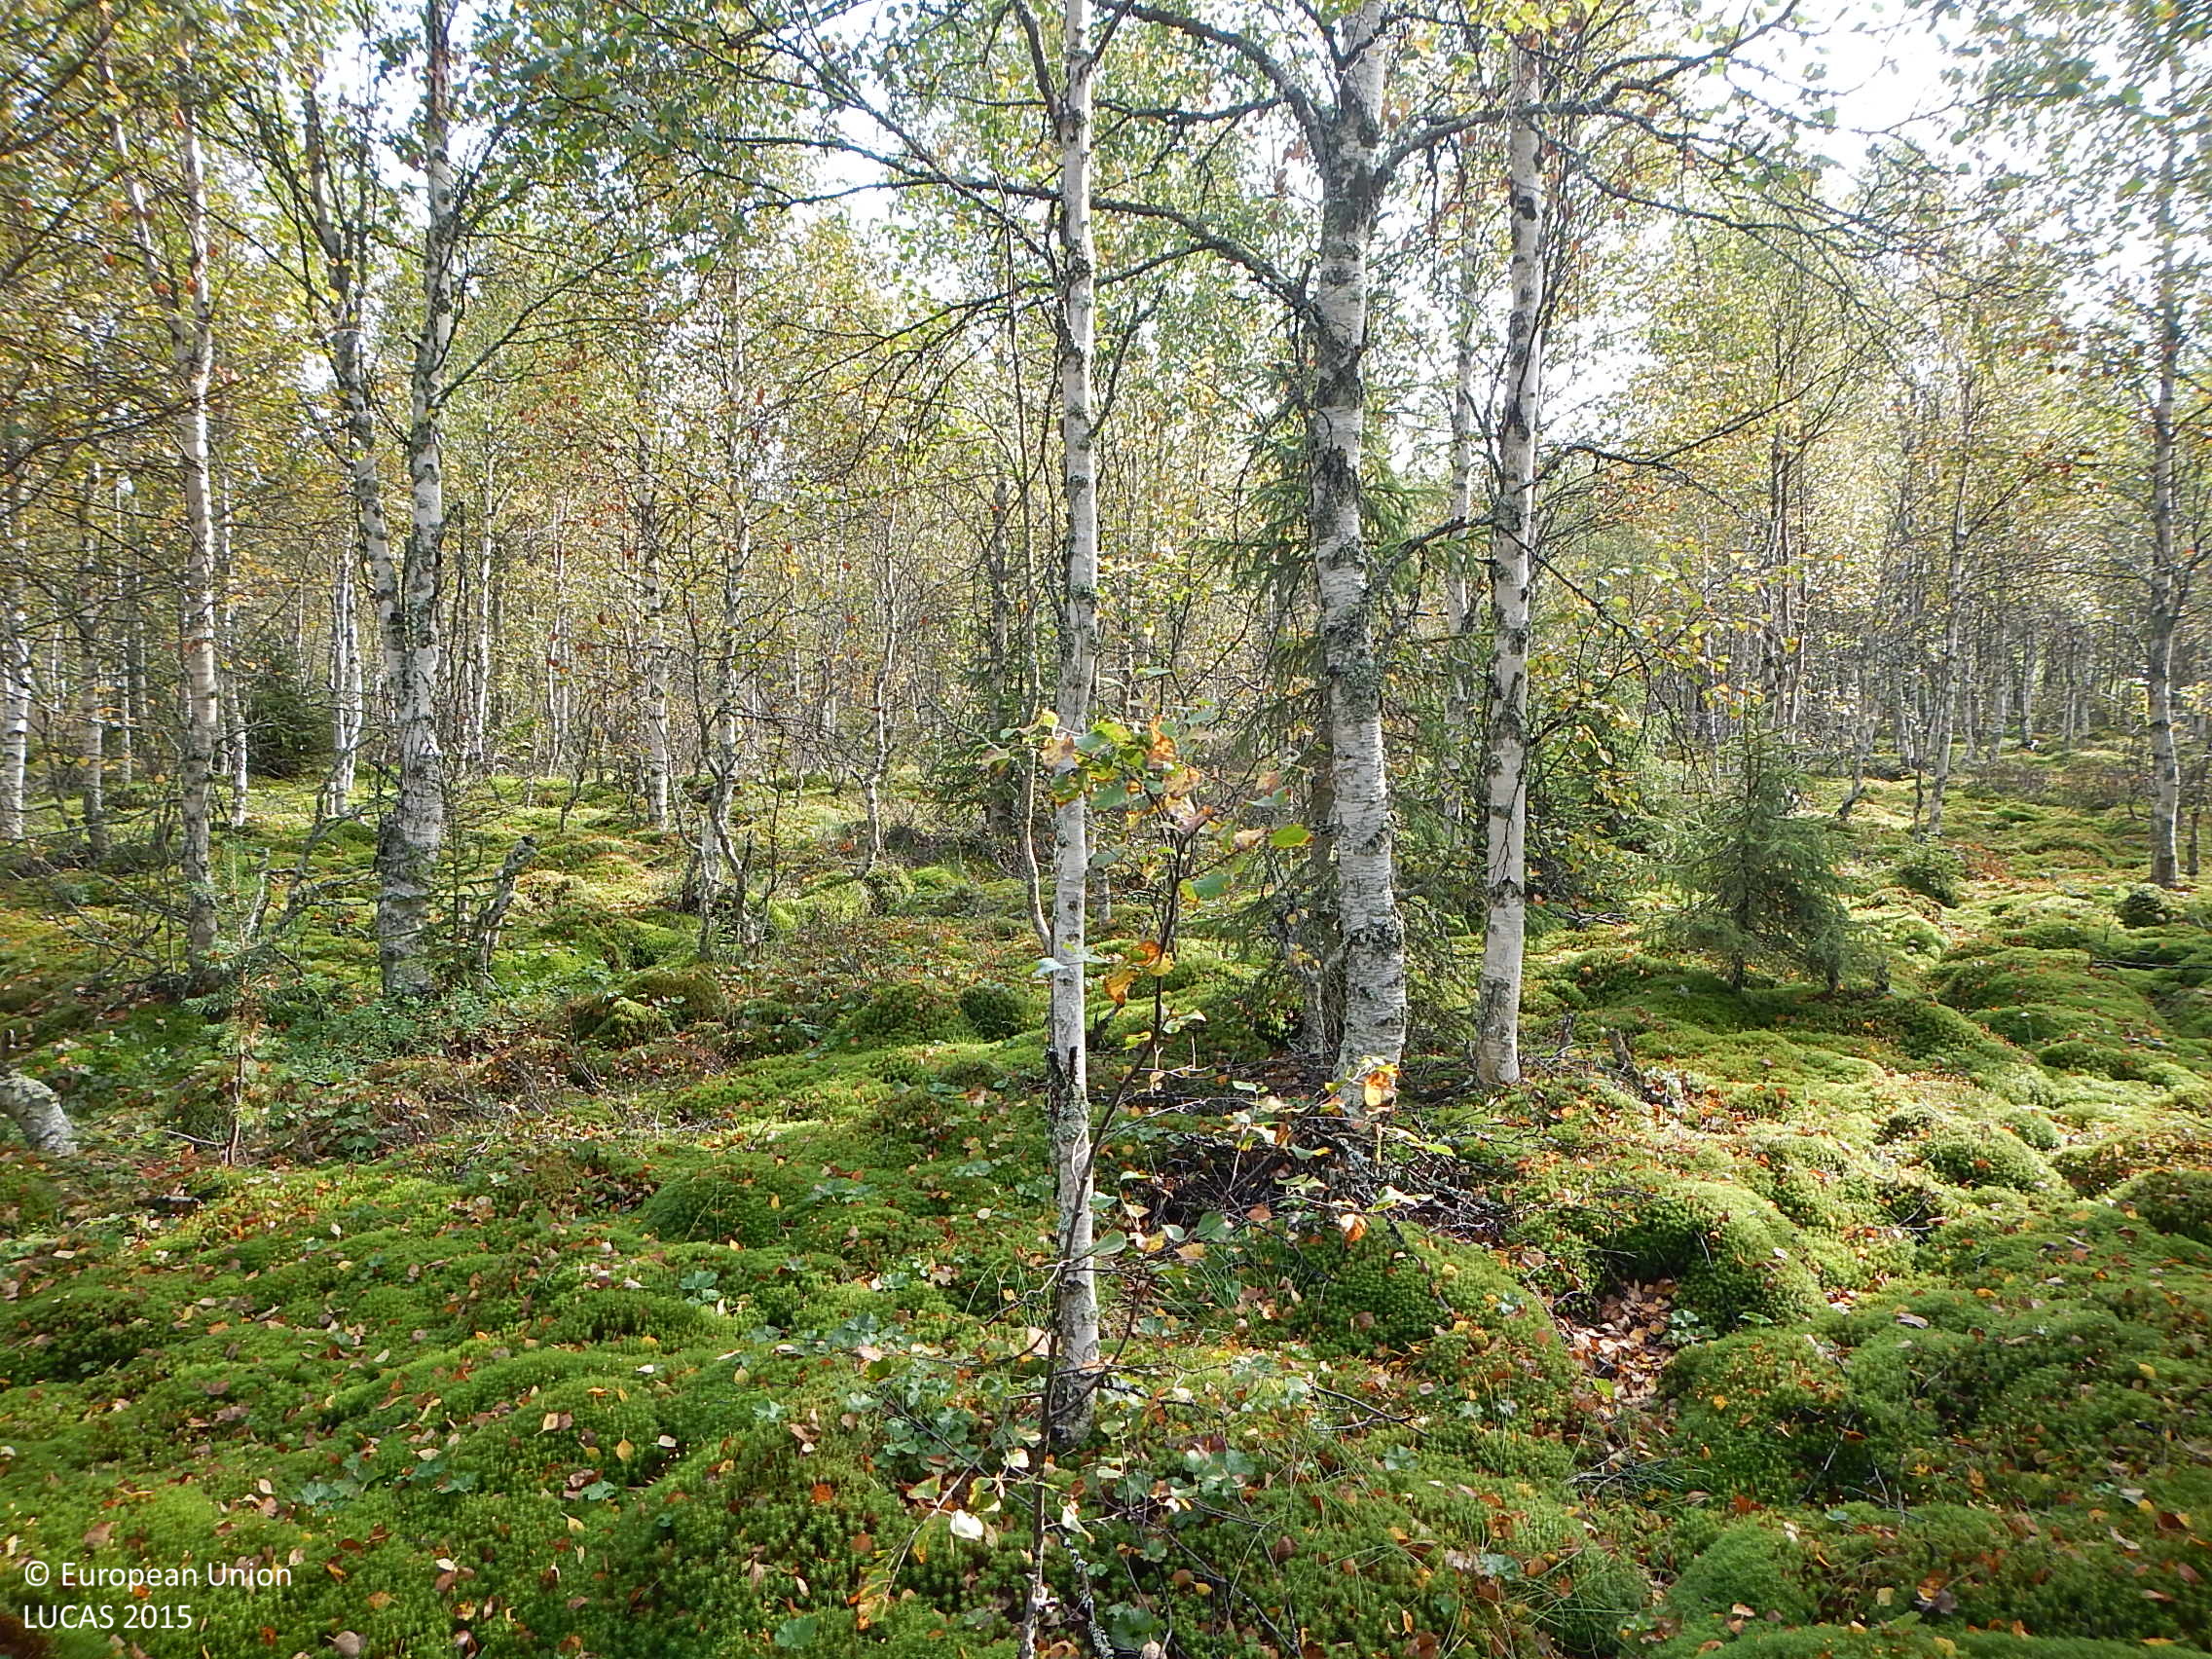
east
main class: Woodland
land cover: Broadleaved woodland
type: mire and swamp forests
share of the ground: > 75 %
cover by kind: broadleaved forest trees 75 %, lichens and mosses 20 %, herbaceous plants 5 %
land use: Forestry
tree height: > 5 m
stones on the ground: < 10 %
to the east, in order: Broadleaved woodland; Ditches and canals; Broadleaved woodland; Ditches and canals; Broadleaved woodland; Ditches and canals; Broadleaved woodland; Ditches and canals; Broadleaved woodland; Ditches and canals; Broadleaved woodland; Ditches and canals; Broadleaved woodland; Rivers and streams; Broadleaved woodland
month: August
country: FI
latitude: 65.7415
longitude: 26.9719
